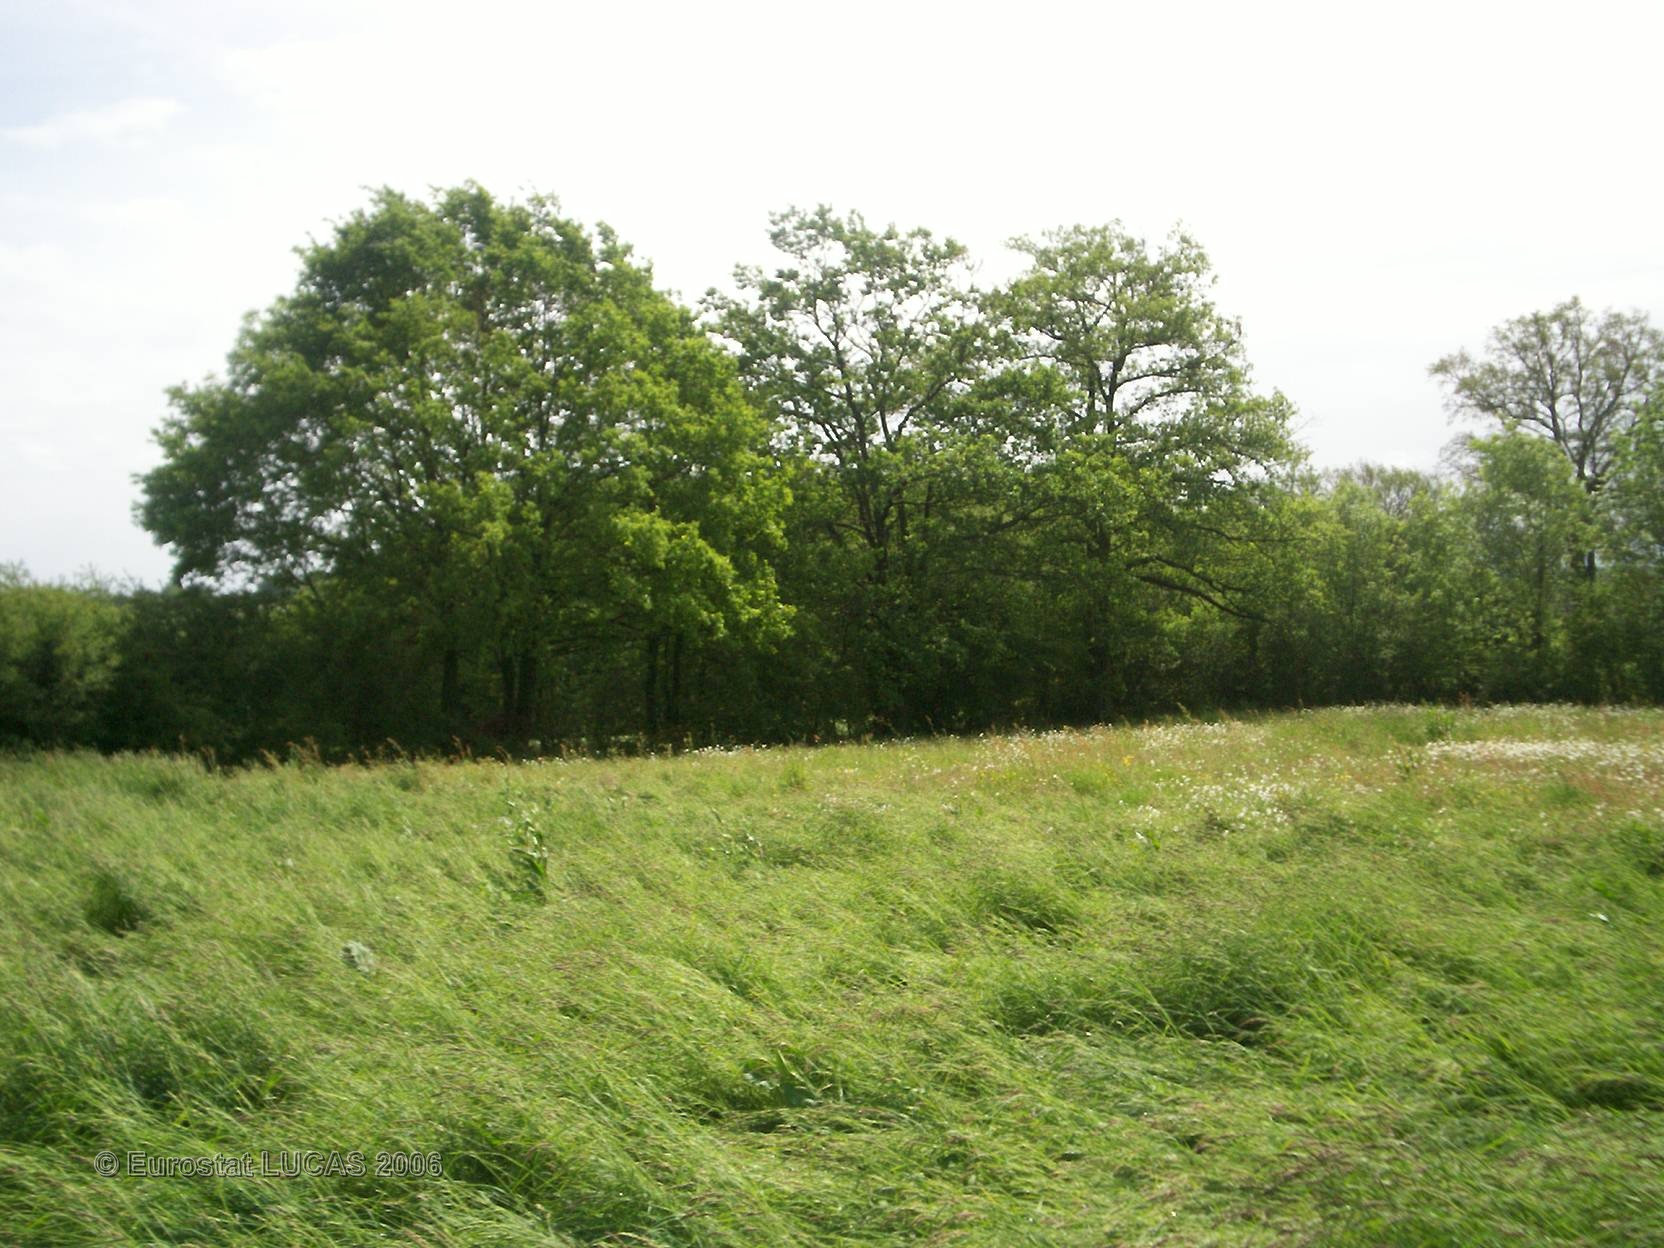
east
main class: Grassland
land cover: Grassland without tree/shrub cover
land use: Agriculture (excluding fallow land and kitchen gardens)
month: May
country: FR
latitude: 46.5100
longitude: 1.6103
